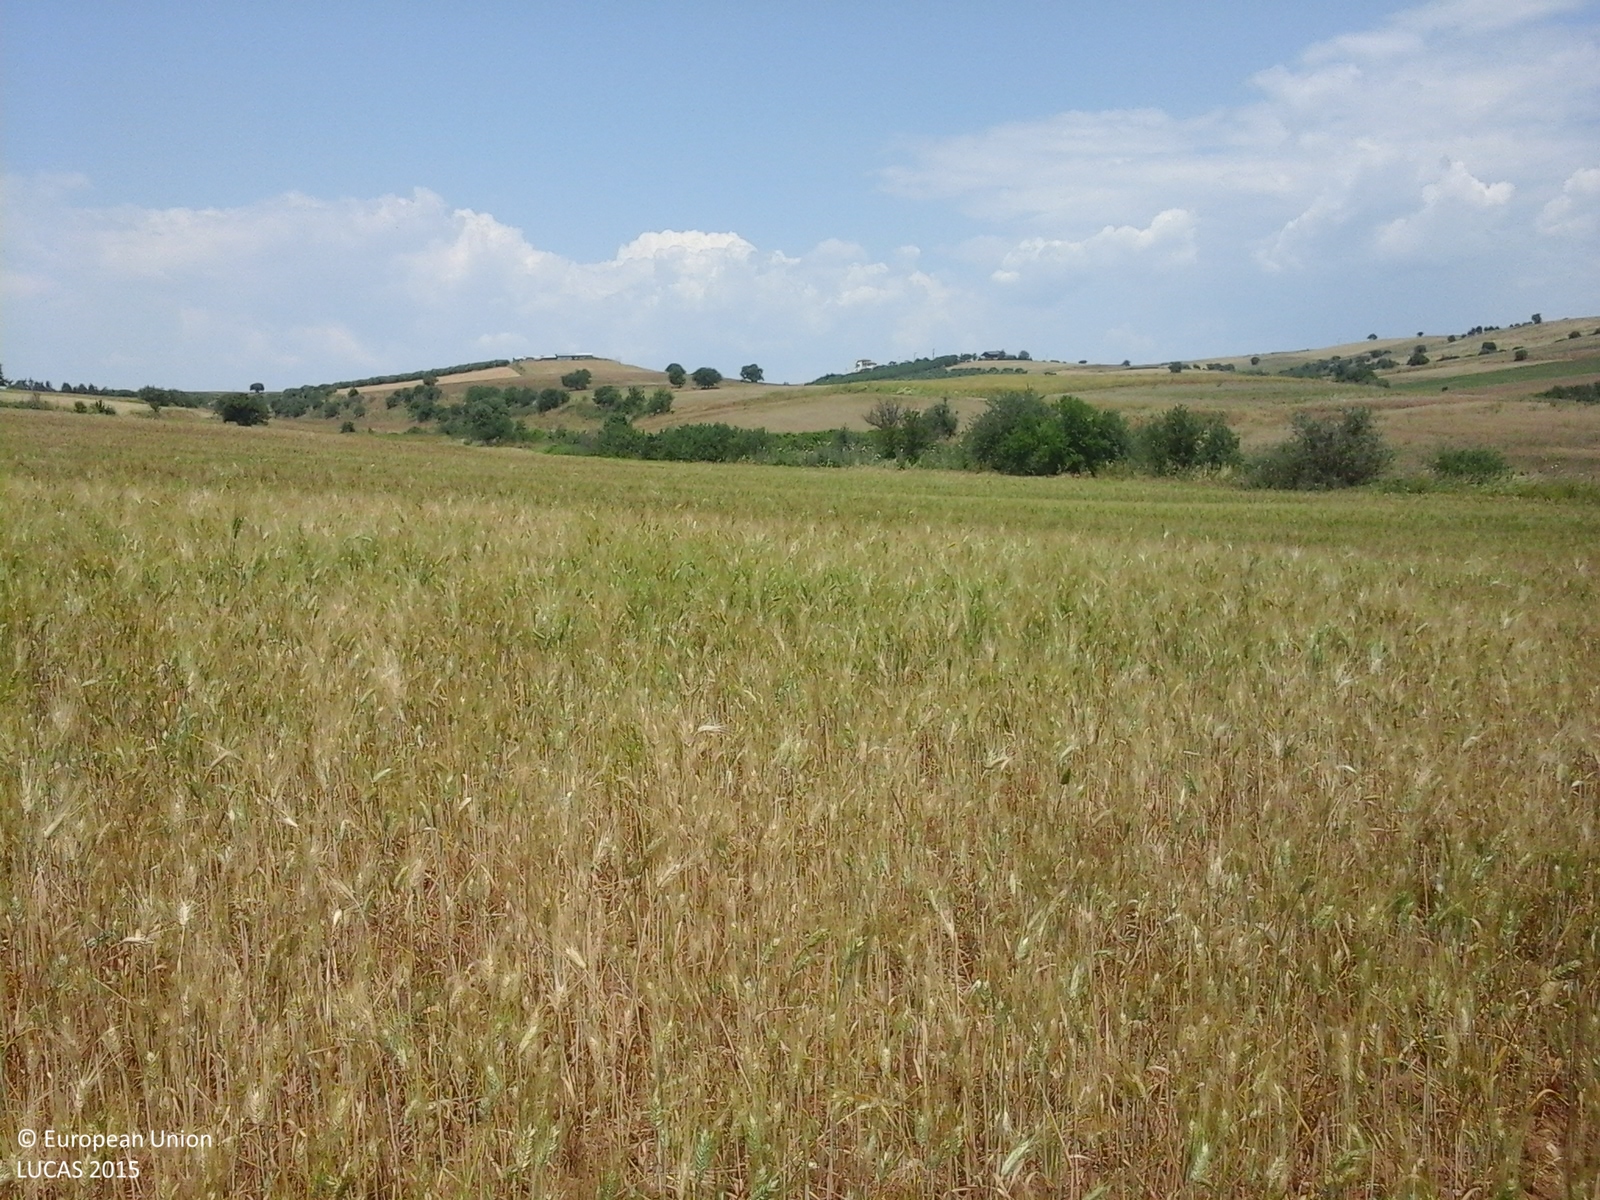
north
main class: Cropland
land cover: Common wheat
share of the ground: > 75 %
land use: Agriculture (excluding fallow land and kitchen gardens)
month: June
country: GR
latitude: 40.4555
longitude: 22.8931
